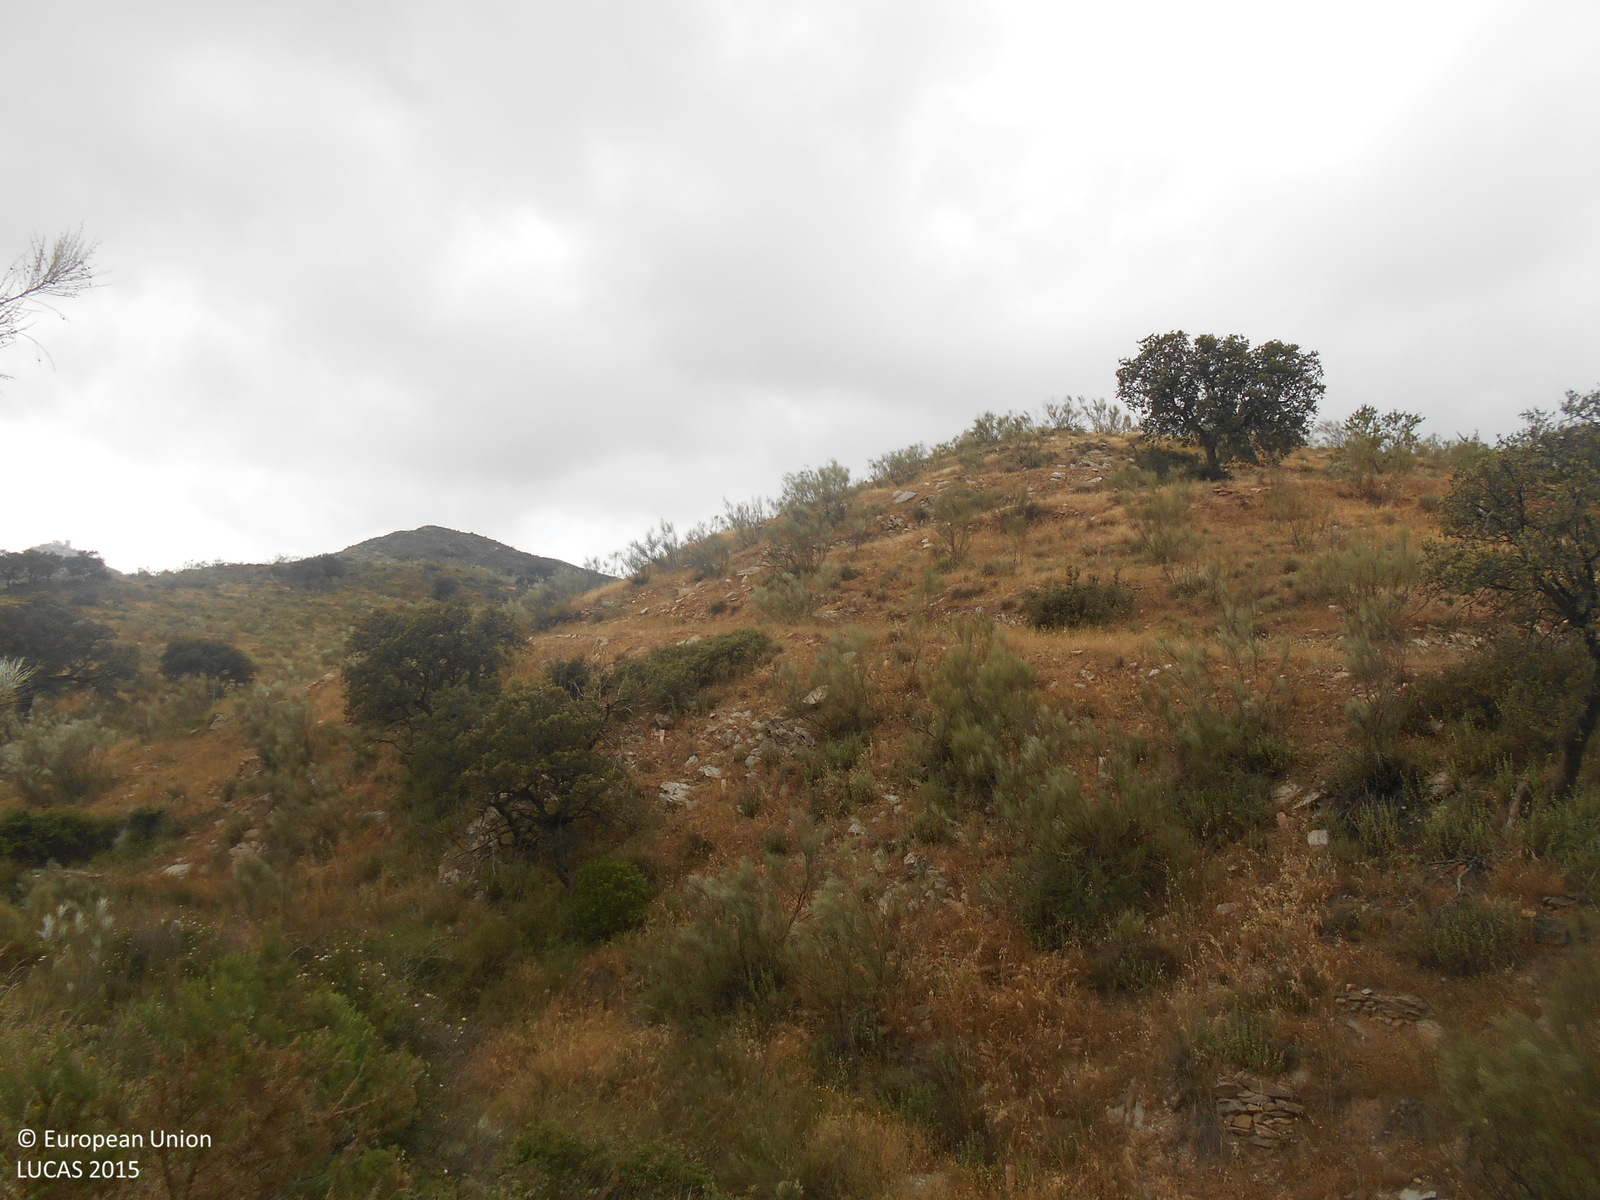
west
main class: Shrubland
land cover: Shrubland with sparse tree cover
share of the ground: > 75 %
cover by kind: shrubs 80 %, herbaceous plants 15 %, broadleaved forest trees 5 %
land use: Semi-natural and natural areas not in use
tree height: < 5 m
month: May
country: ES
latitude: 37.2175
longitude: -2.1836
